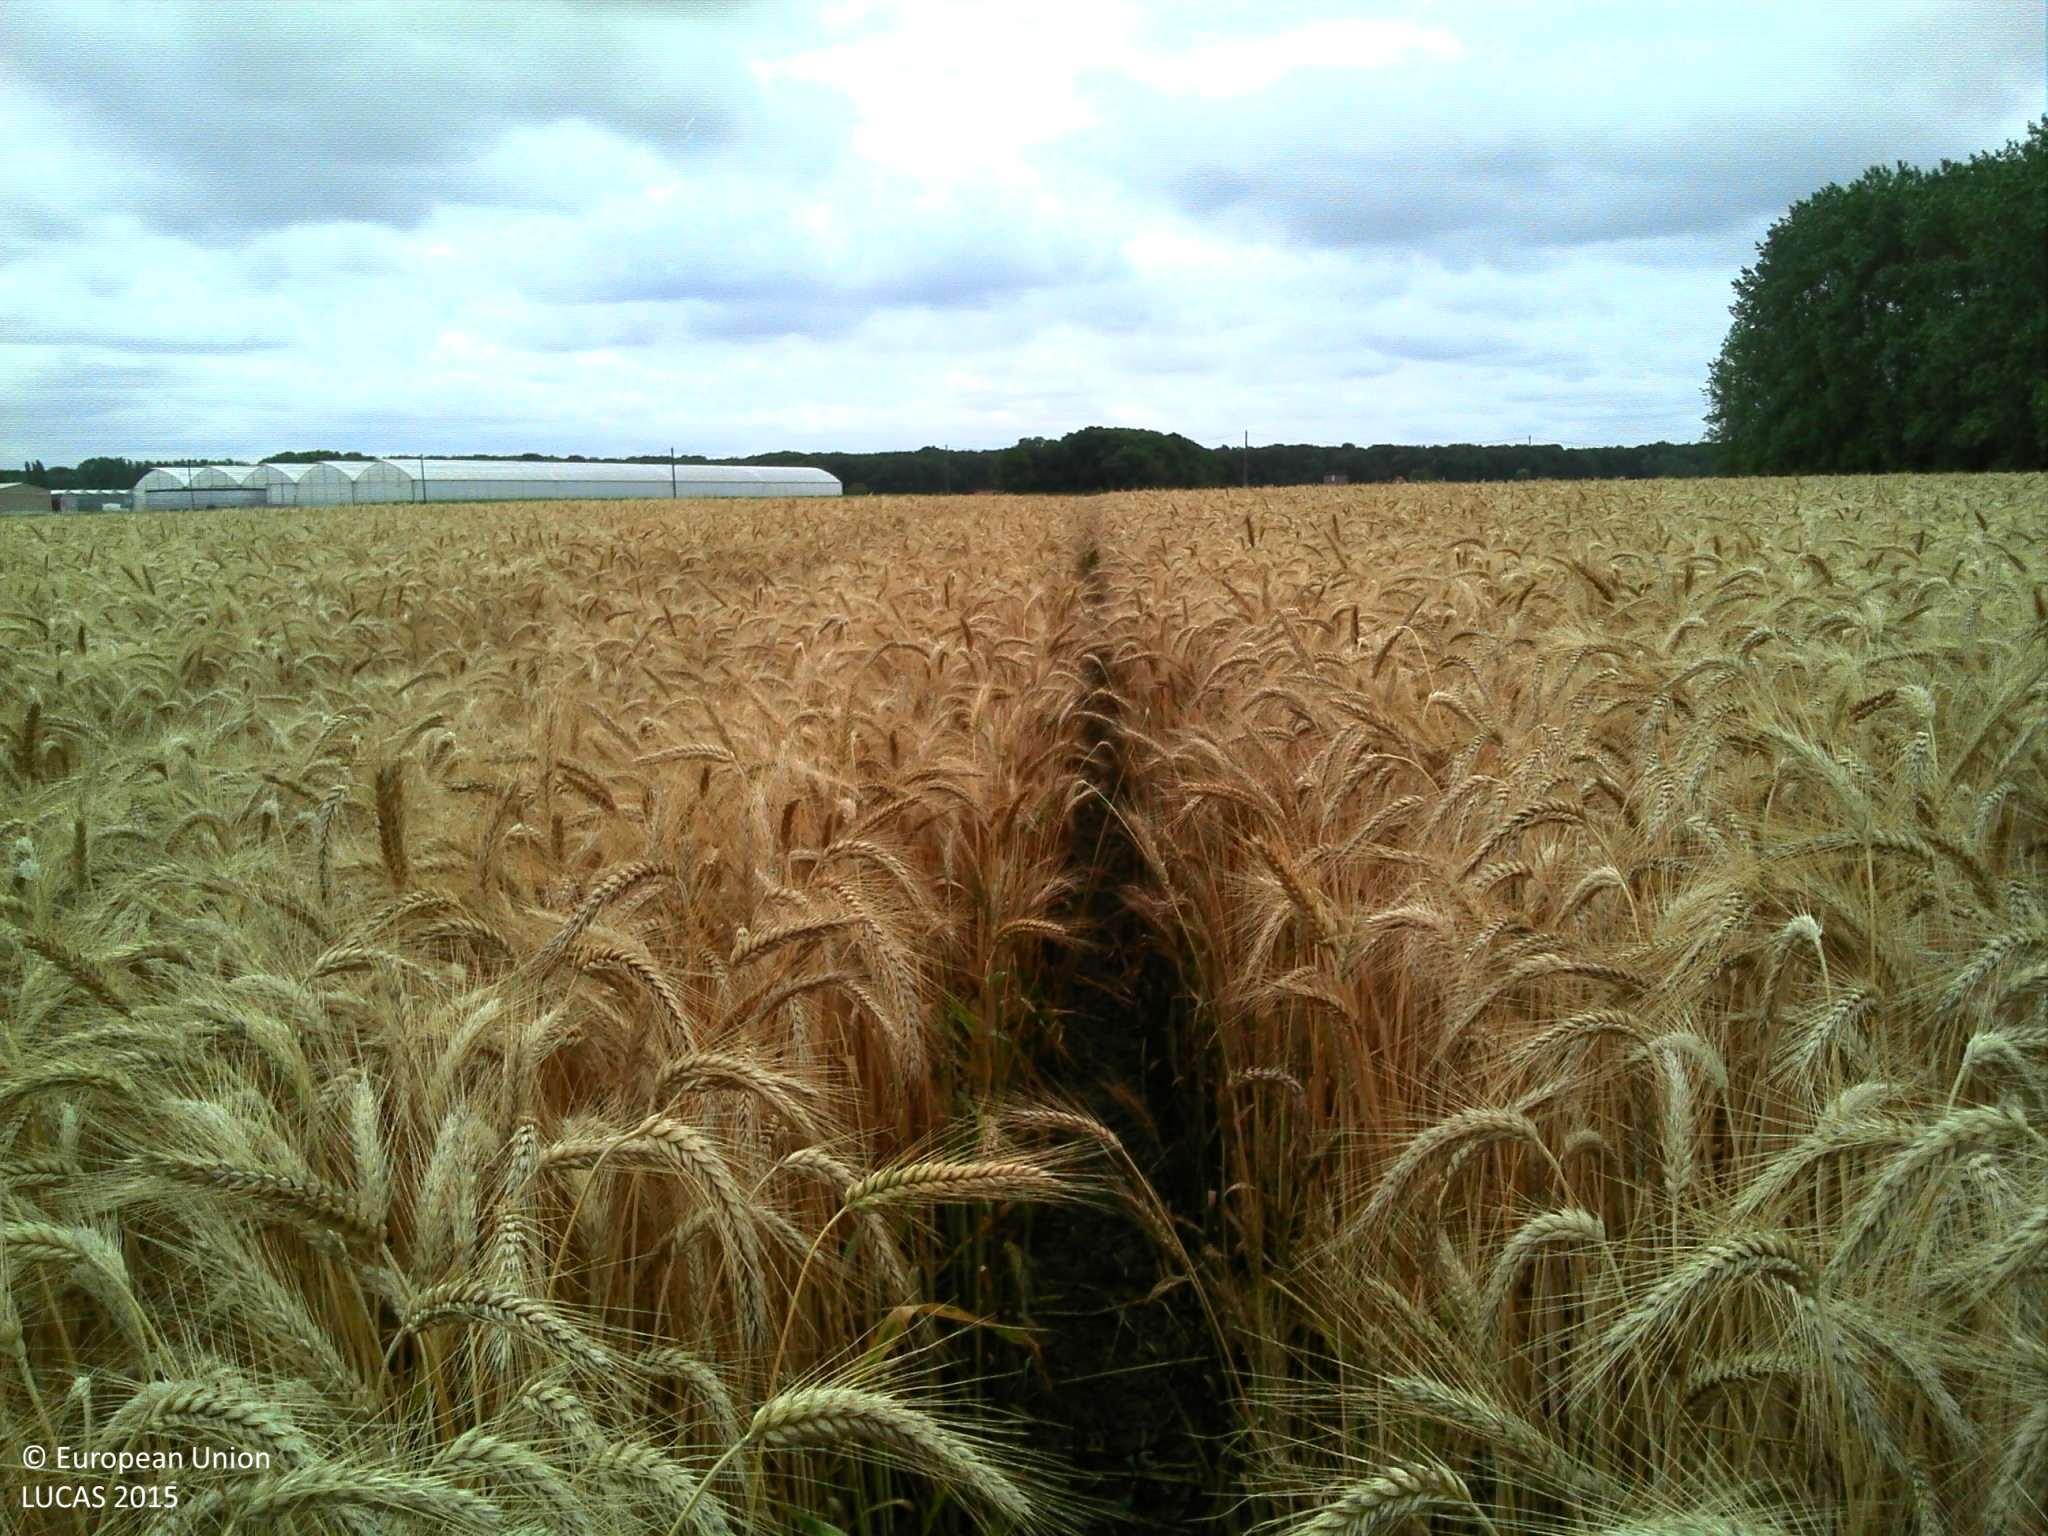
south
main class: Cropland
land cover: Triticale
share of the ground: > 75 %
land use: Agriculture (excluding fallow land and kitchen gardens)
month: July
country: FR
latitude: 50.4480
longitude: 3.1606
